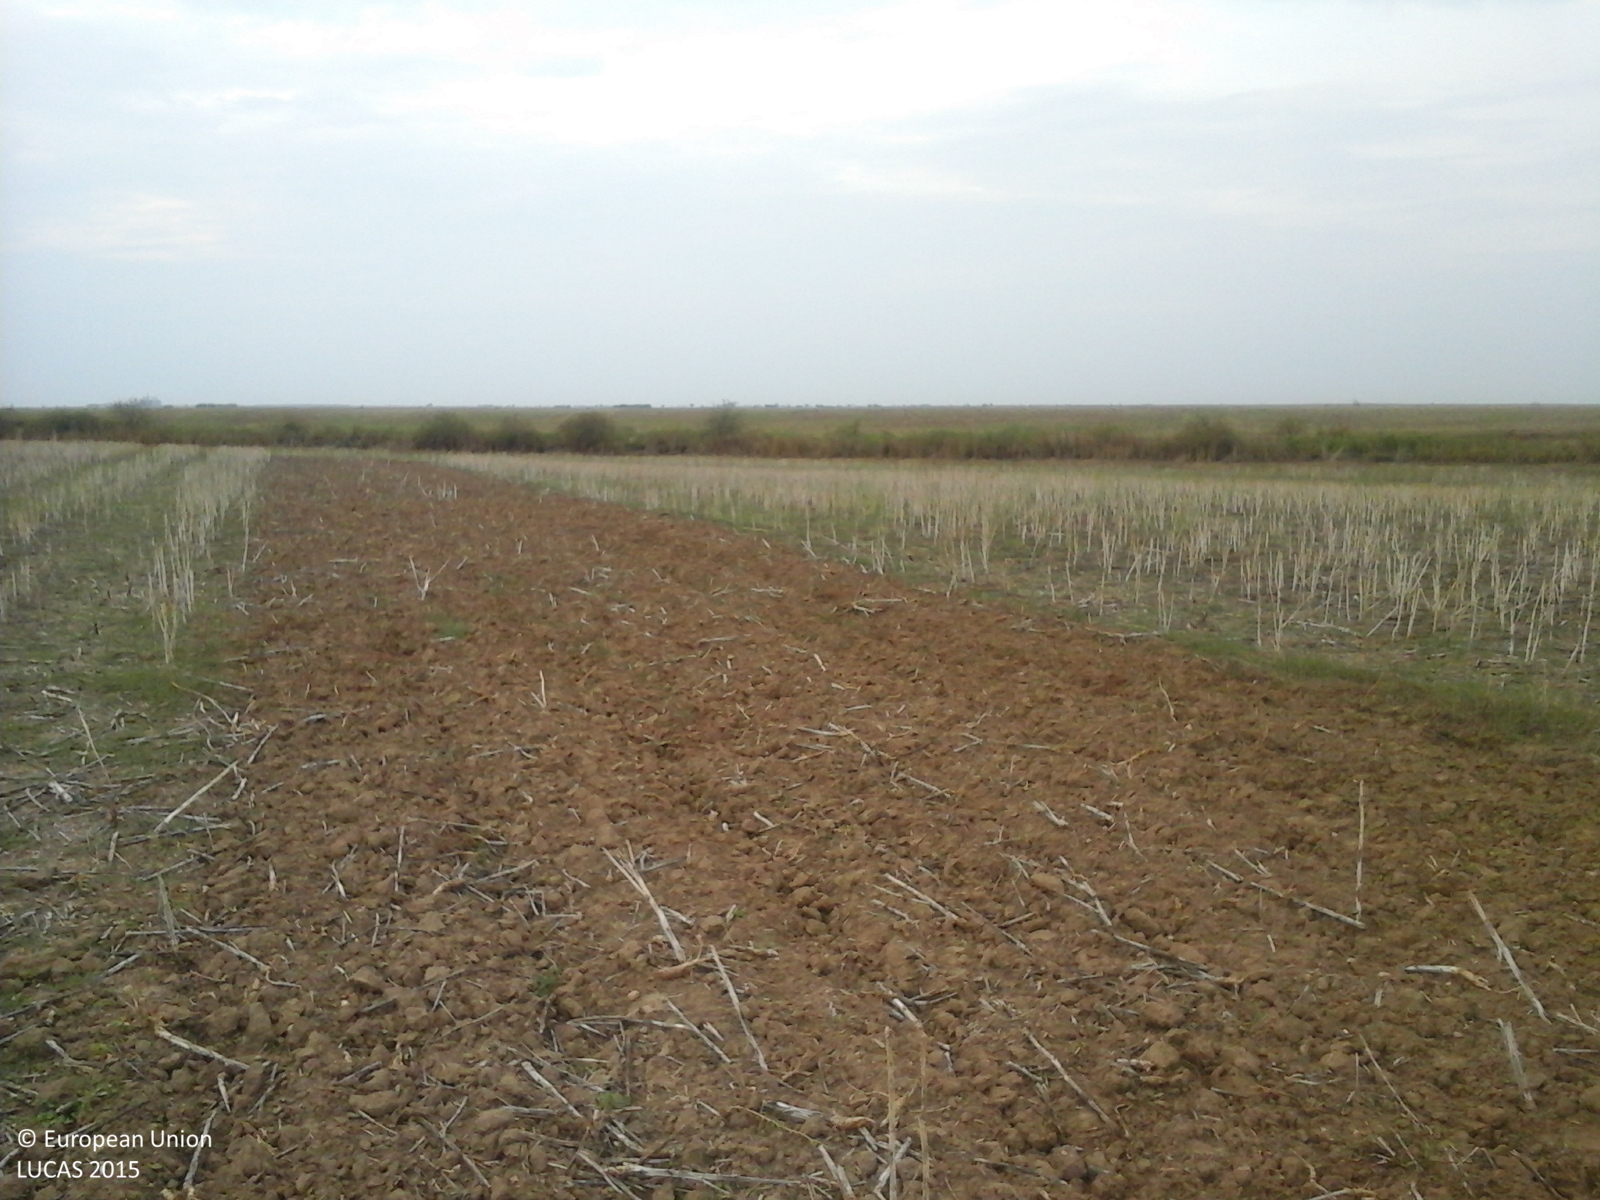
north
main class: Cropland
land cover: Rape and turnip rape
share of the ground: < 10 %
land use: Agriculture (excluding fallow land and kitchen gardens)
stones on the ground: < 10 %
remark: Harvested field
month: August
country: RO
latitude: 46.1804
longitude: 21.5272
